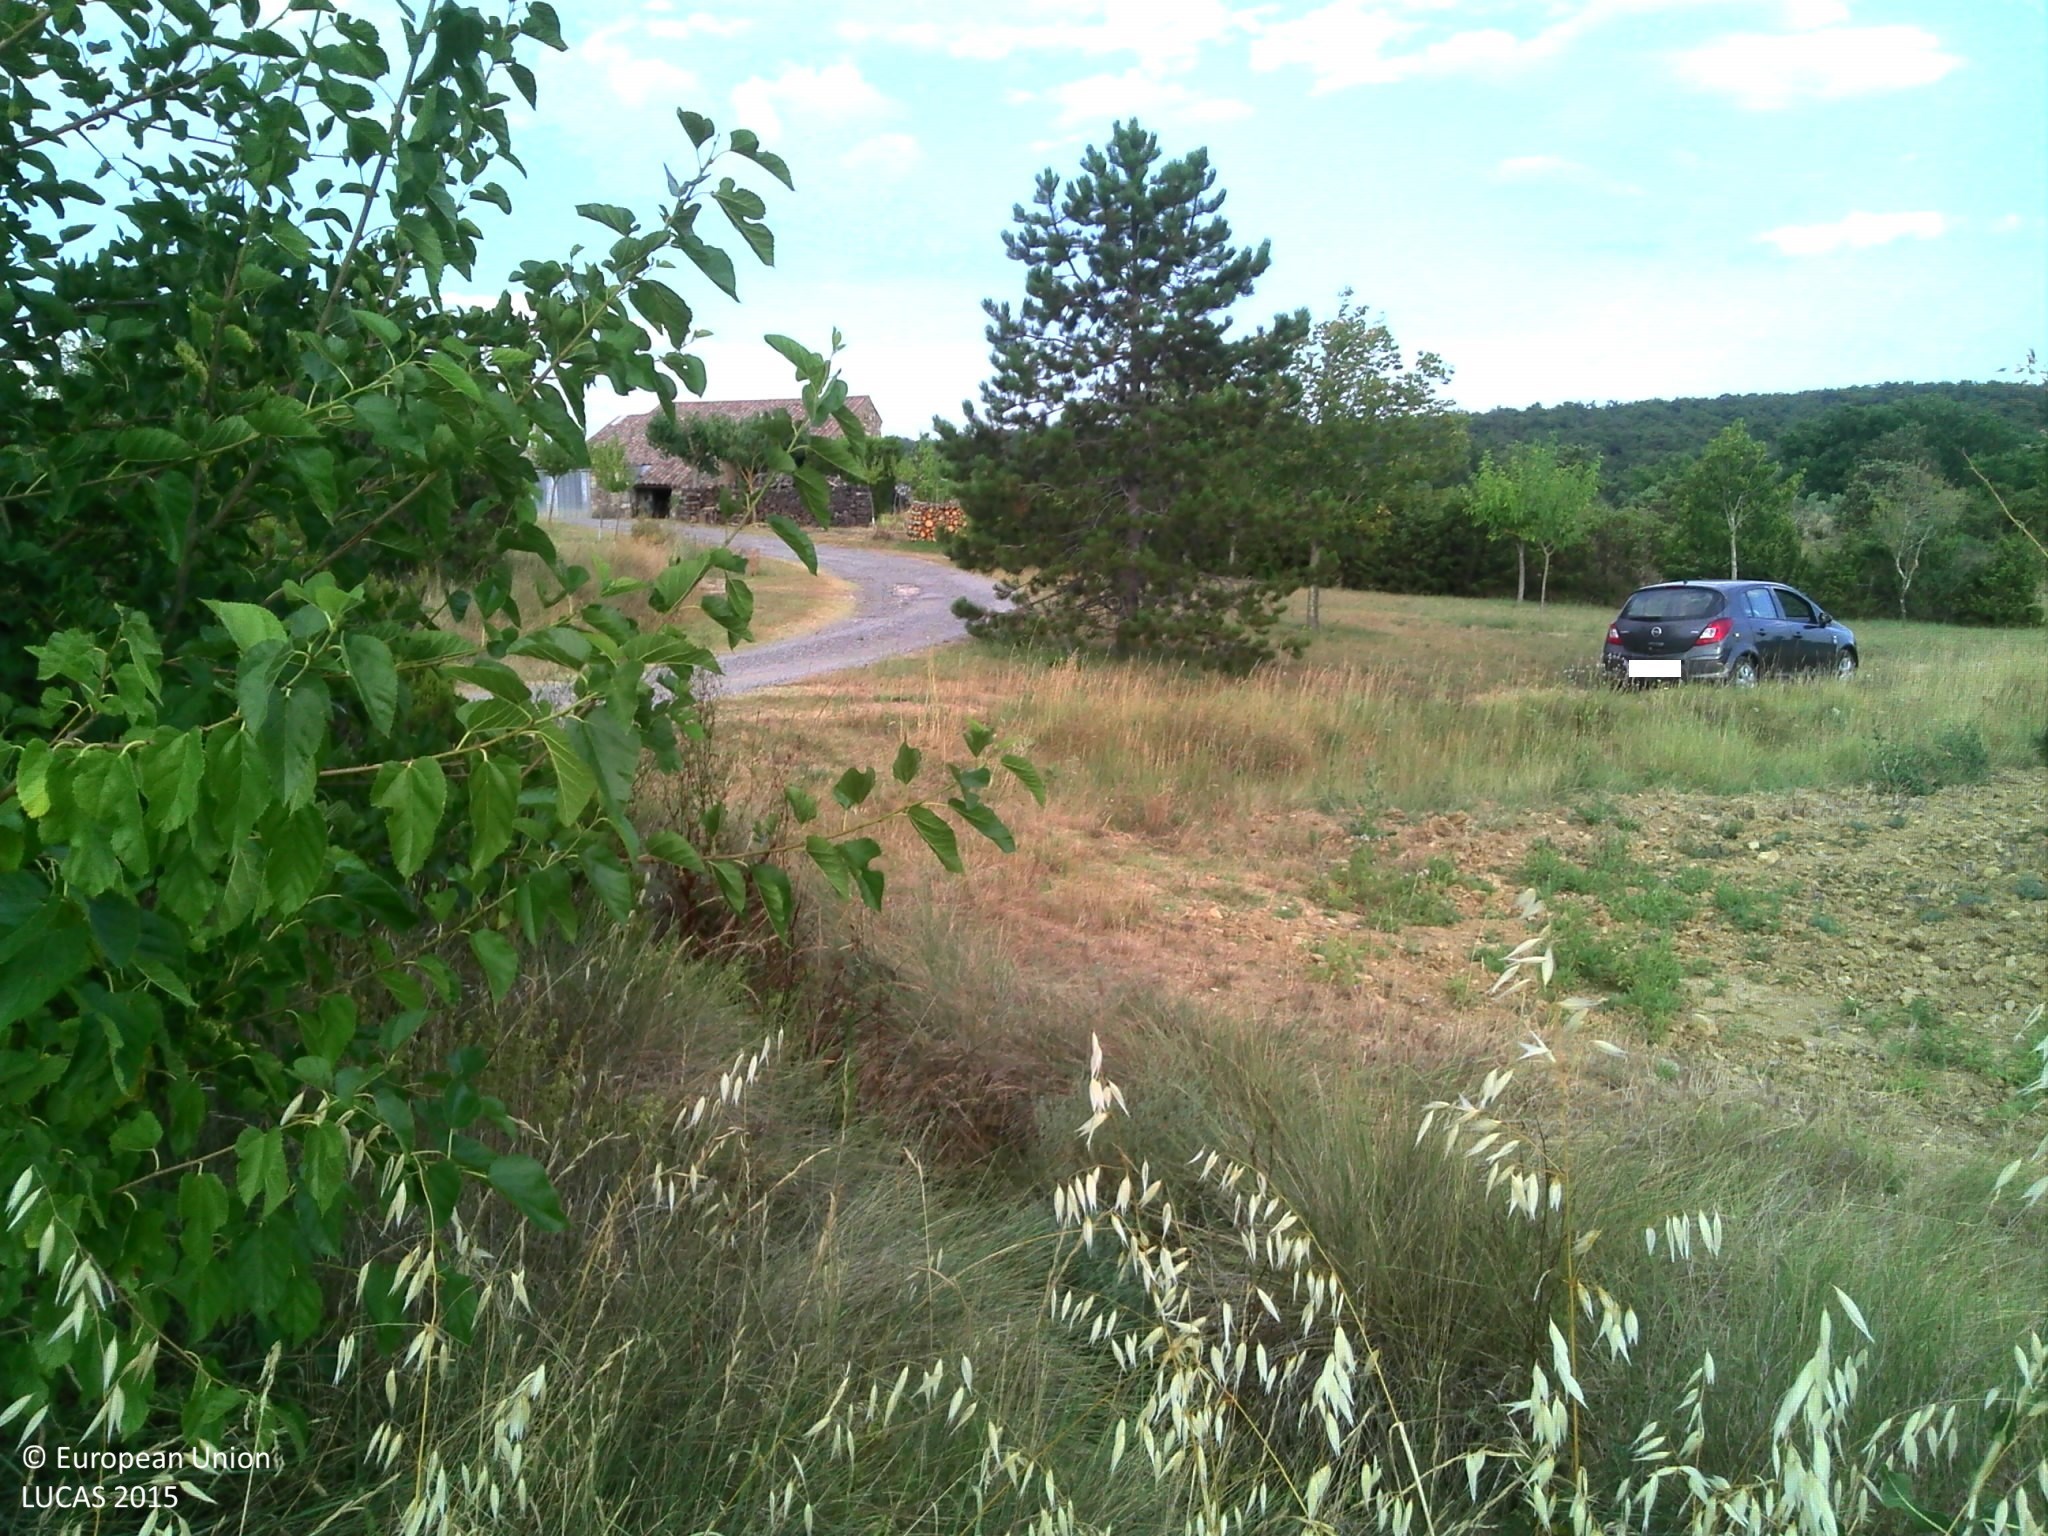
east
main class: Cropland
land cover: Tomatoes
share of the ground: 10 - 25 %
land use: Agriculture (excluding fallow land and kitchen gardens)
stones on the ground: 25 - 50 %
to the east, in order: Tomatoes; Managed hedges; Paved roads, cycling and walking lanes; Grassland with sparse tree/shrub cover; Artificial constructions in urban areas; Grassland without tree/shrub cover; Fences; Grassland without tree/shrub cover; Tracks; Grassland with sparse tree/shrub cover; Broadleaved woodland; Vineyards
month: July
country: FR
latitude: 44.3399
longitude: 4.3252
